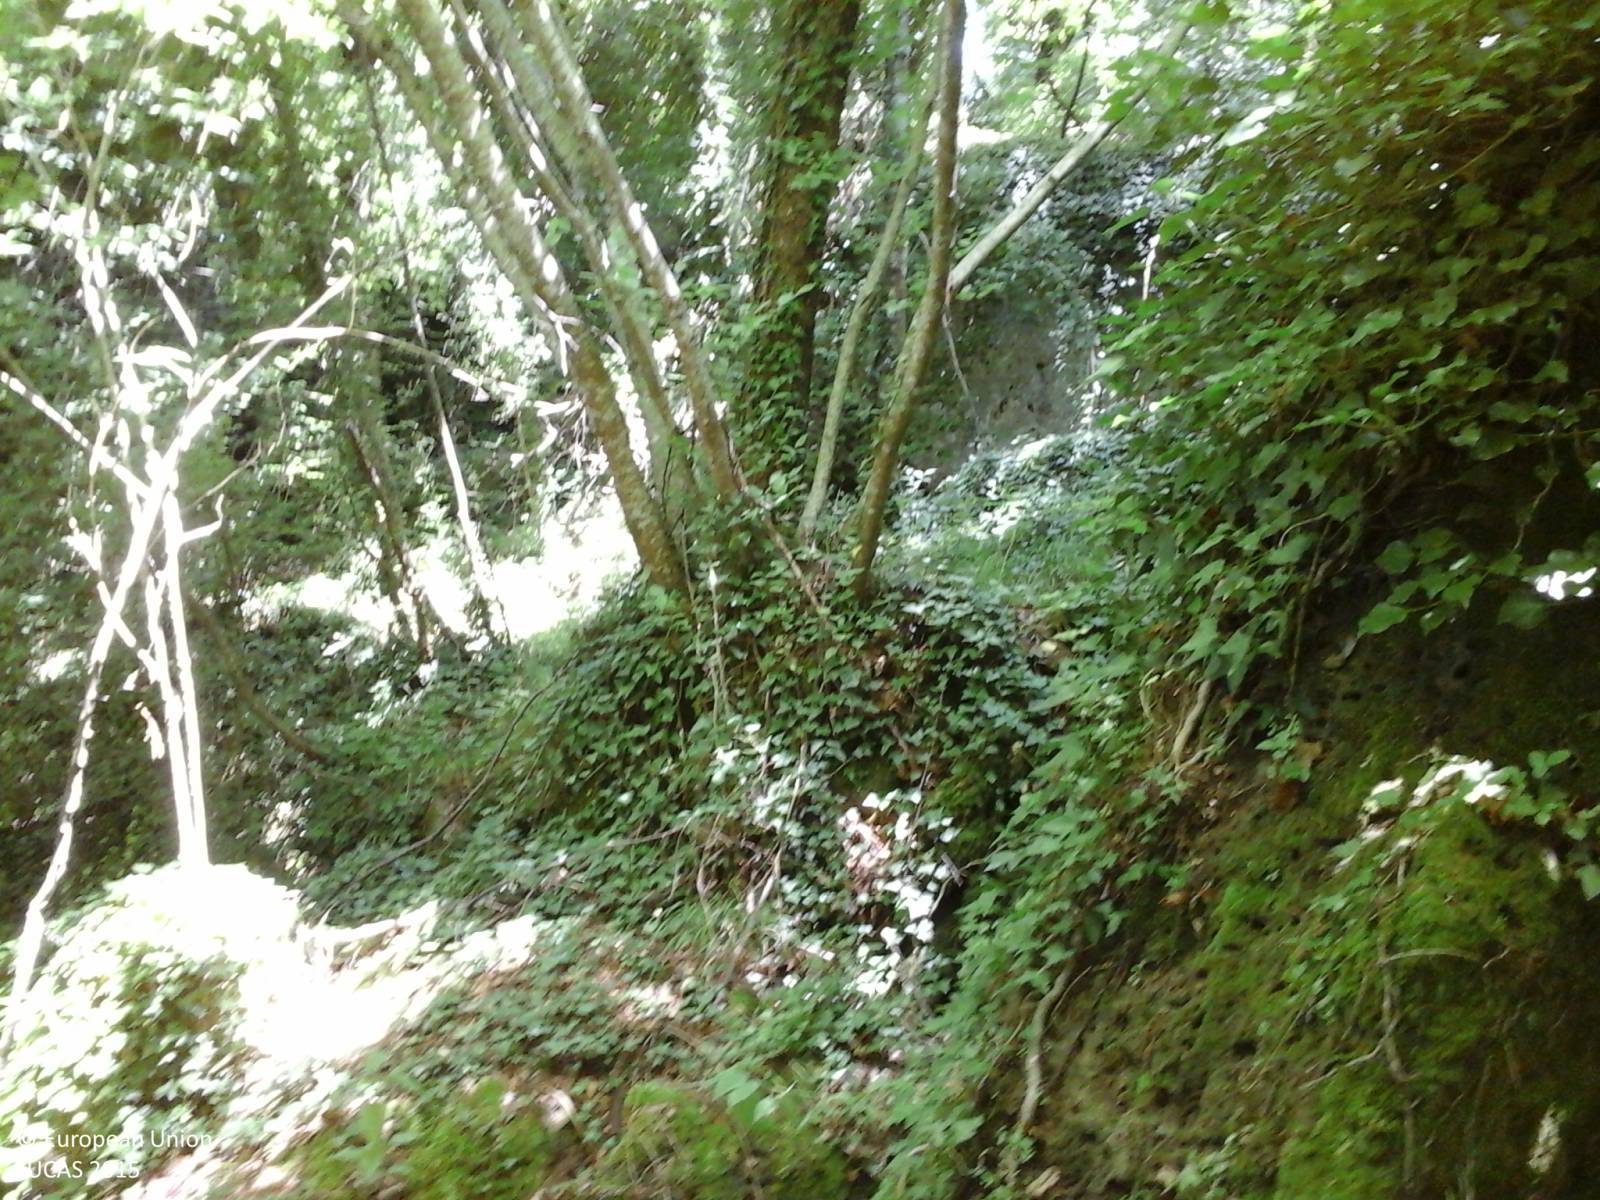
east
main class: Woodland
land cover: Broadleaved woodland
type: thermophilous deciduous forest
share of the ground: > 75 %
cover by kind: broadleaved forest trees 90 %, shrubs 10 %
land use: Forestry
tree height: > 5 m
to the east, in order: Broadleaved woodland
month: June
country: IT
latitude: 42.5027
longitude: 12.2438
